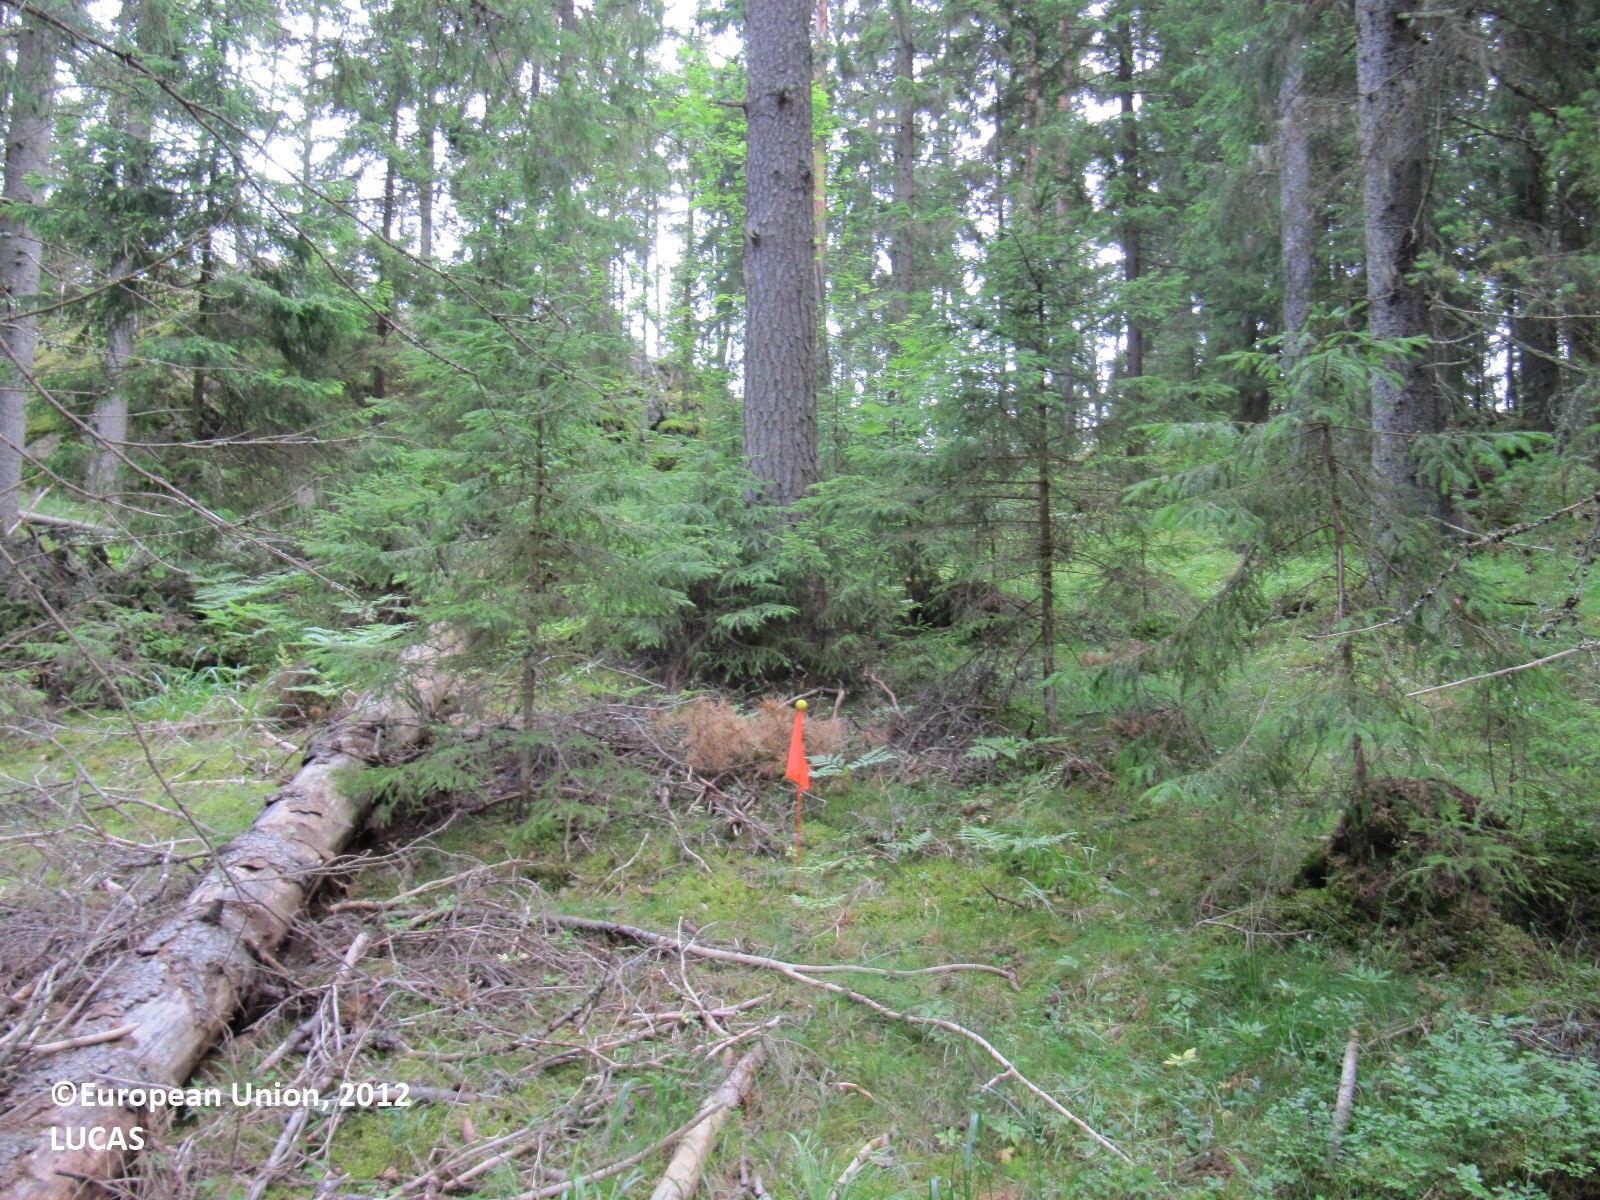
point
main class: Woodland
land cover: Spruce dominated coniferous woodland
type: boreal forest
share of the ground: 50 - 75 %
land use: Forestry
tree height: > 5 m
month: July
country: FI
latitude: 60.8000
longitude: 23.4051
